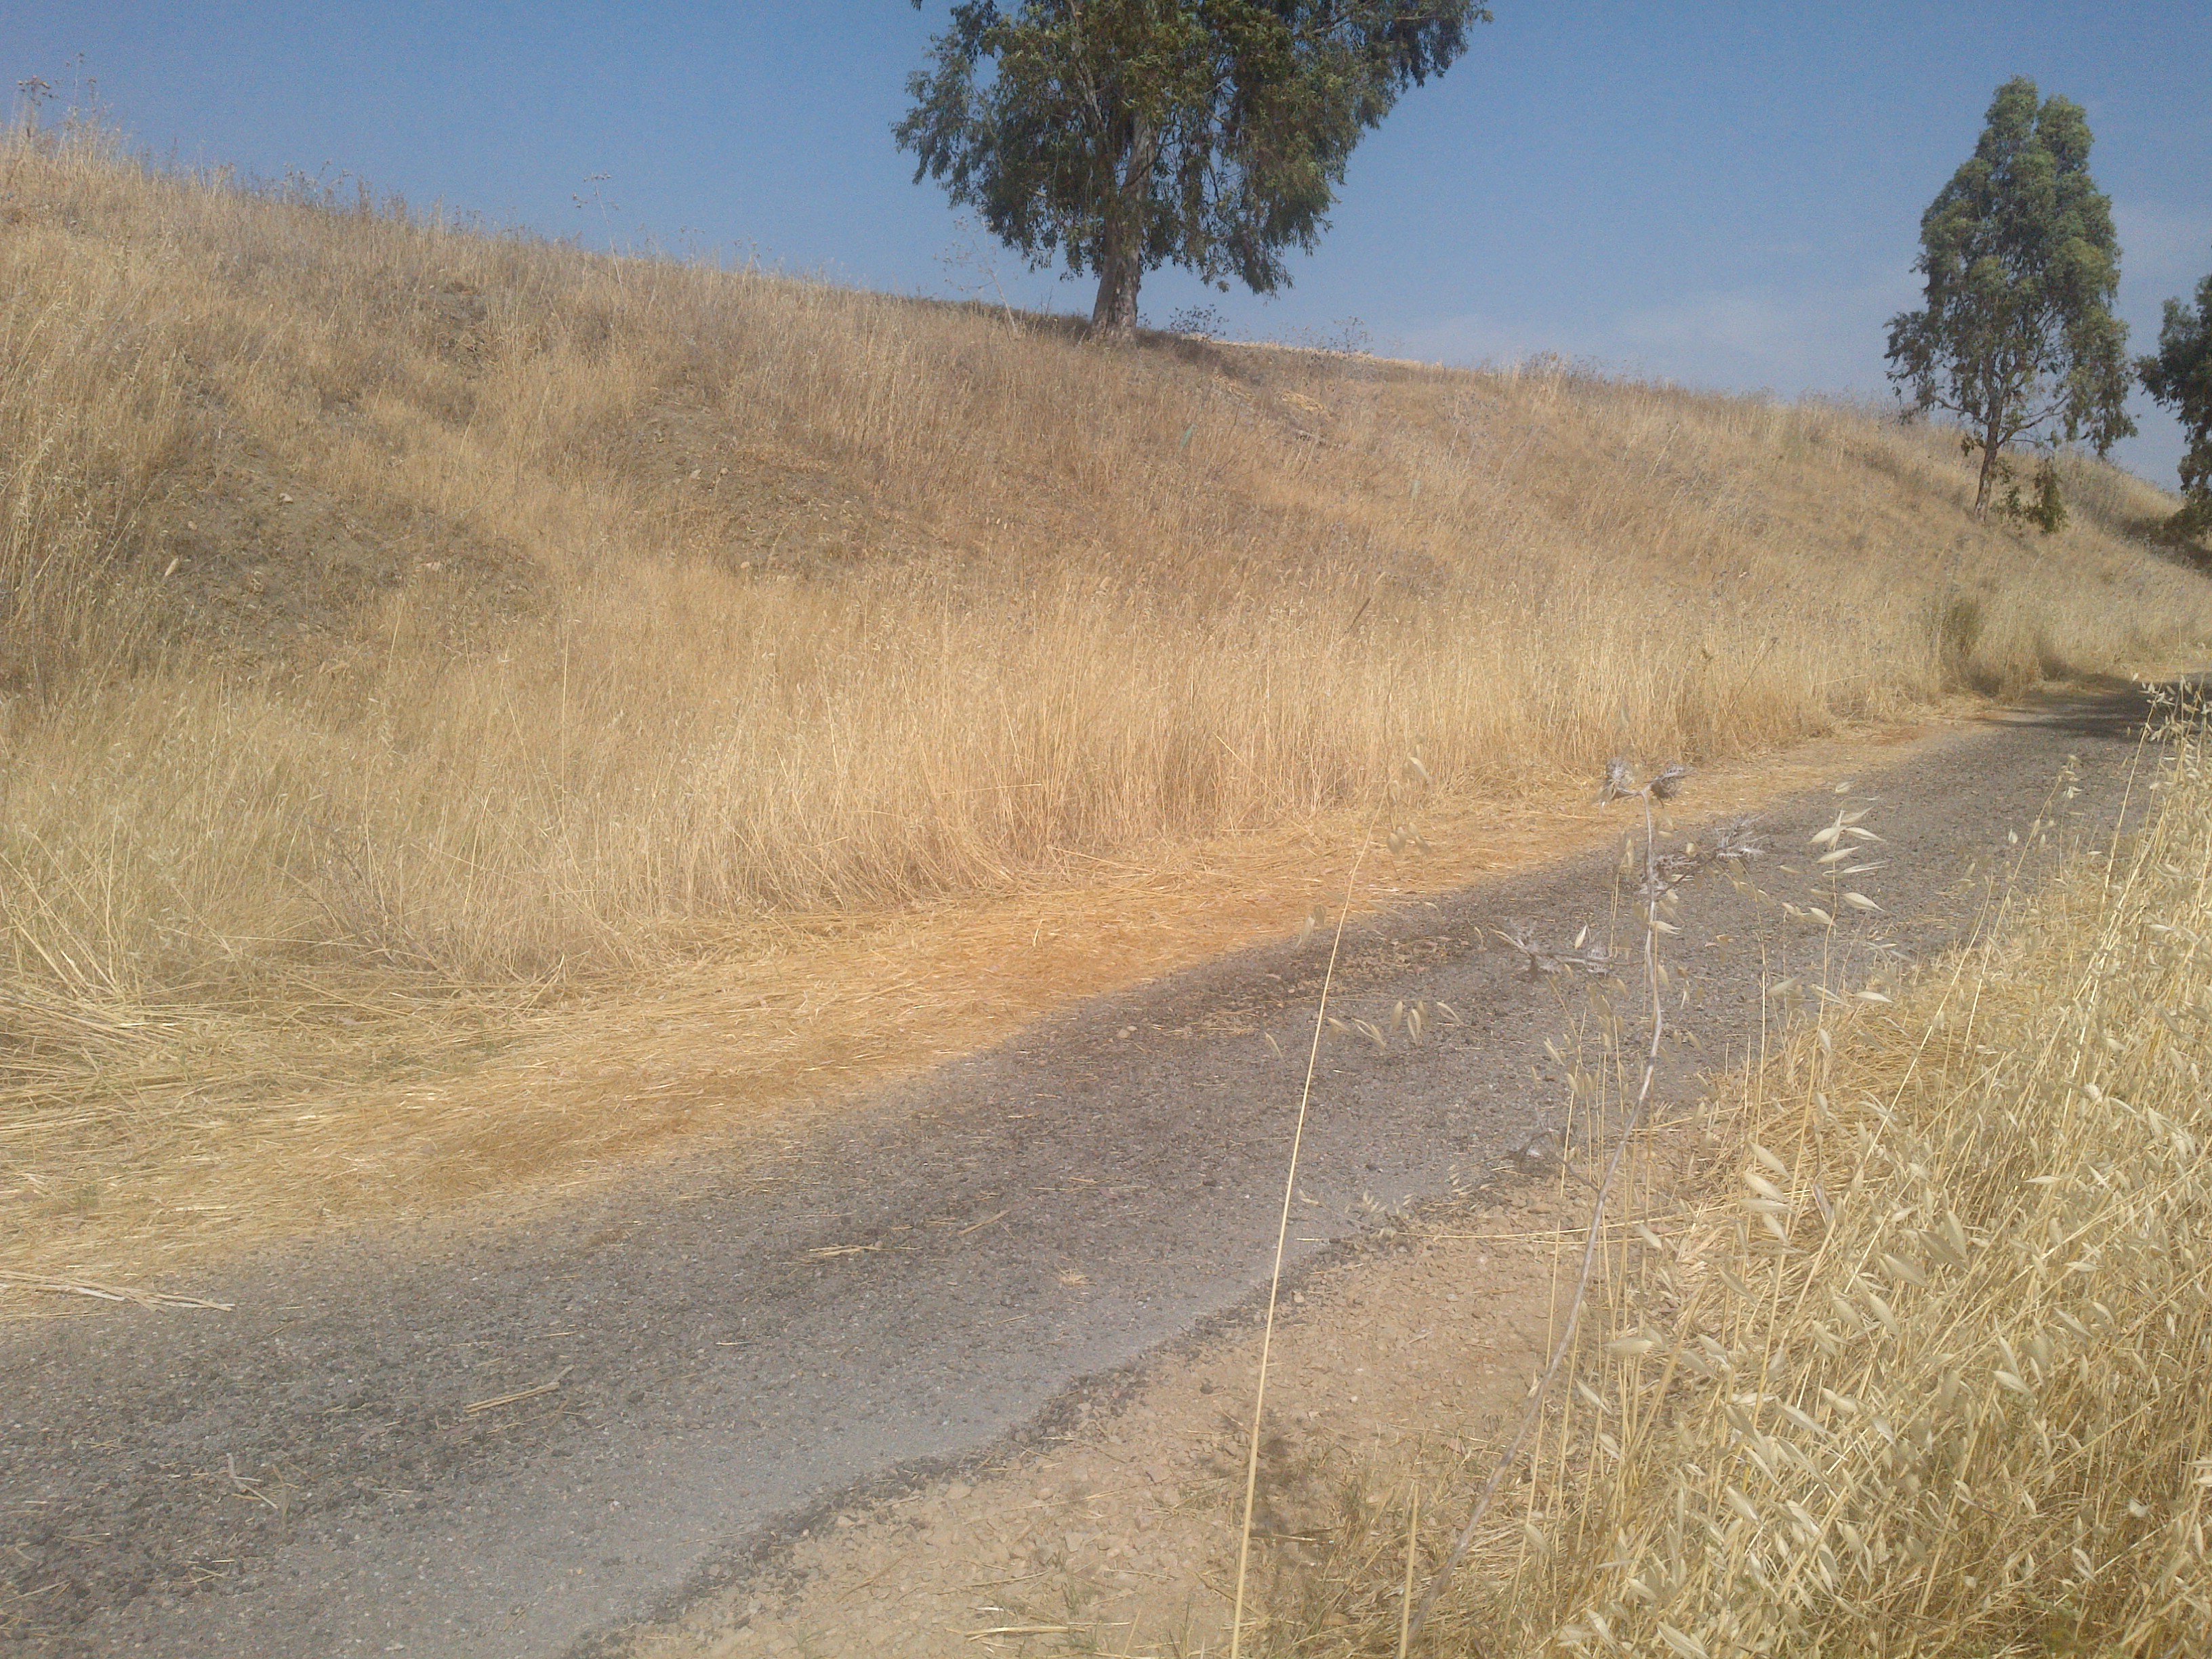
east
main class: Grassland
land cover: Grassland with sparse tree/shrub cover
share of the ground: > 75 %
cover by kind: herbaceous plants 90 %, broadleaved forest trees 5 %, unconsolidated bare surface 5 %
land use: Road transport
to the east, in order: Grassland with sparse tree/shrub cover; Paved roads, cycling and walking lanes; Grassland with sparse tree/shrub cover; Durum wheat; Sunflower
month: June
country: ES
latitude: 37.7596
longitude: -4.9180
